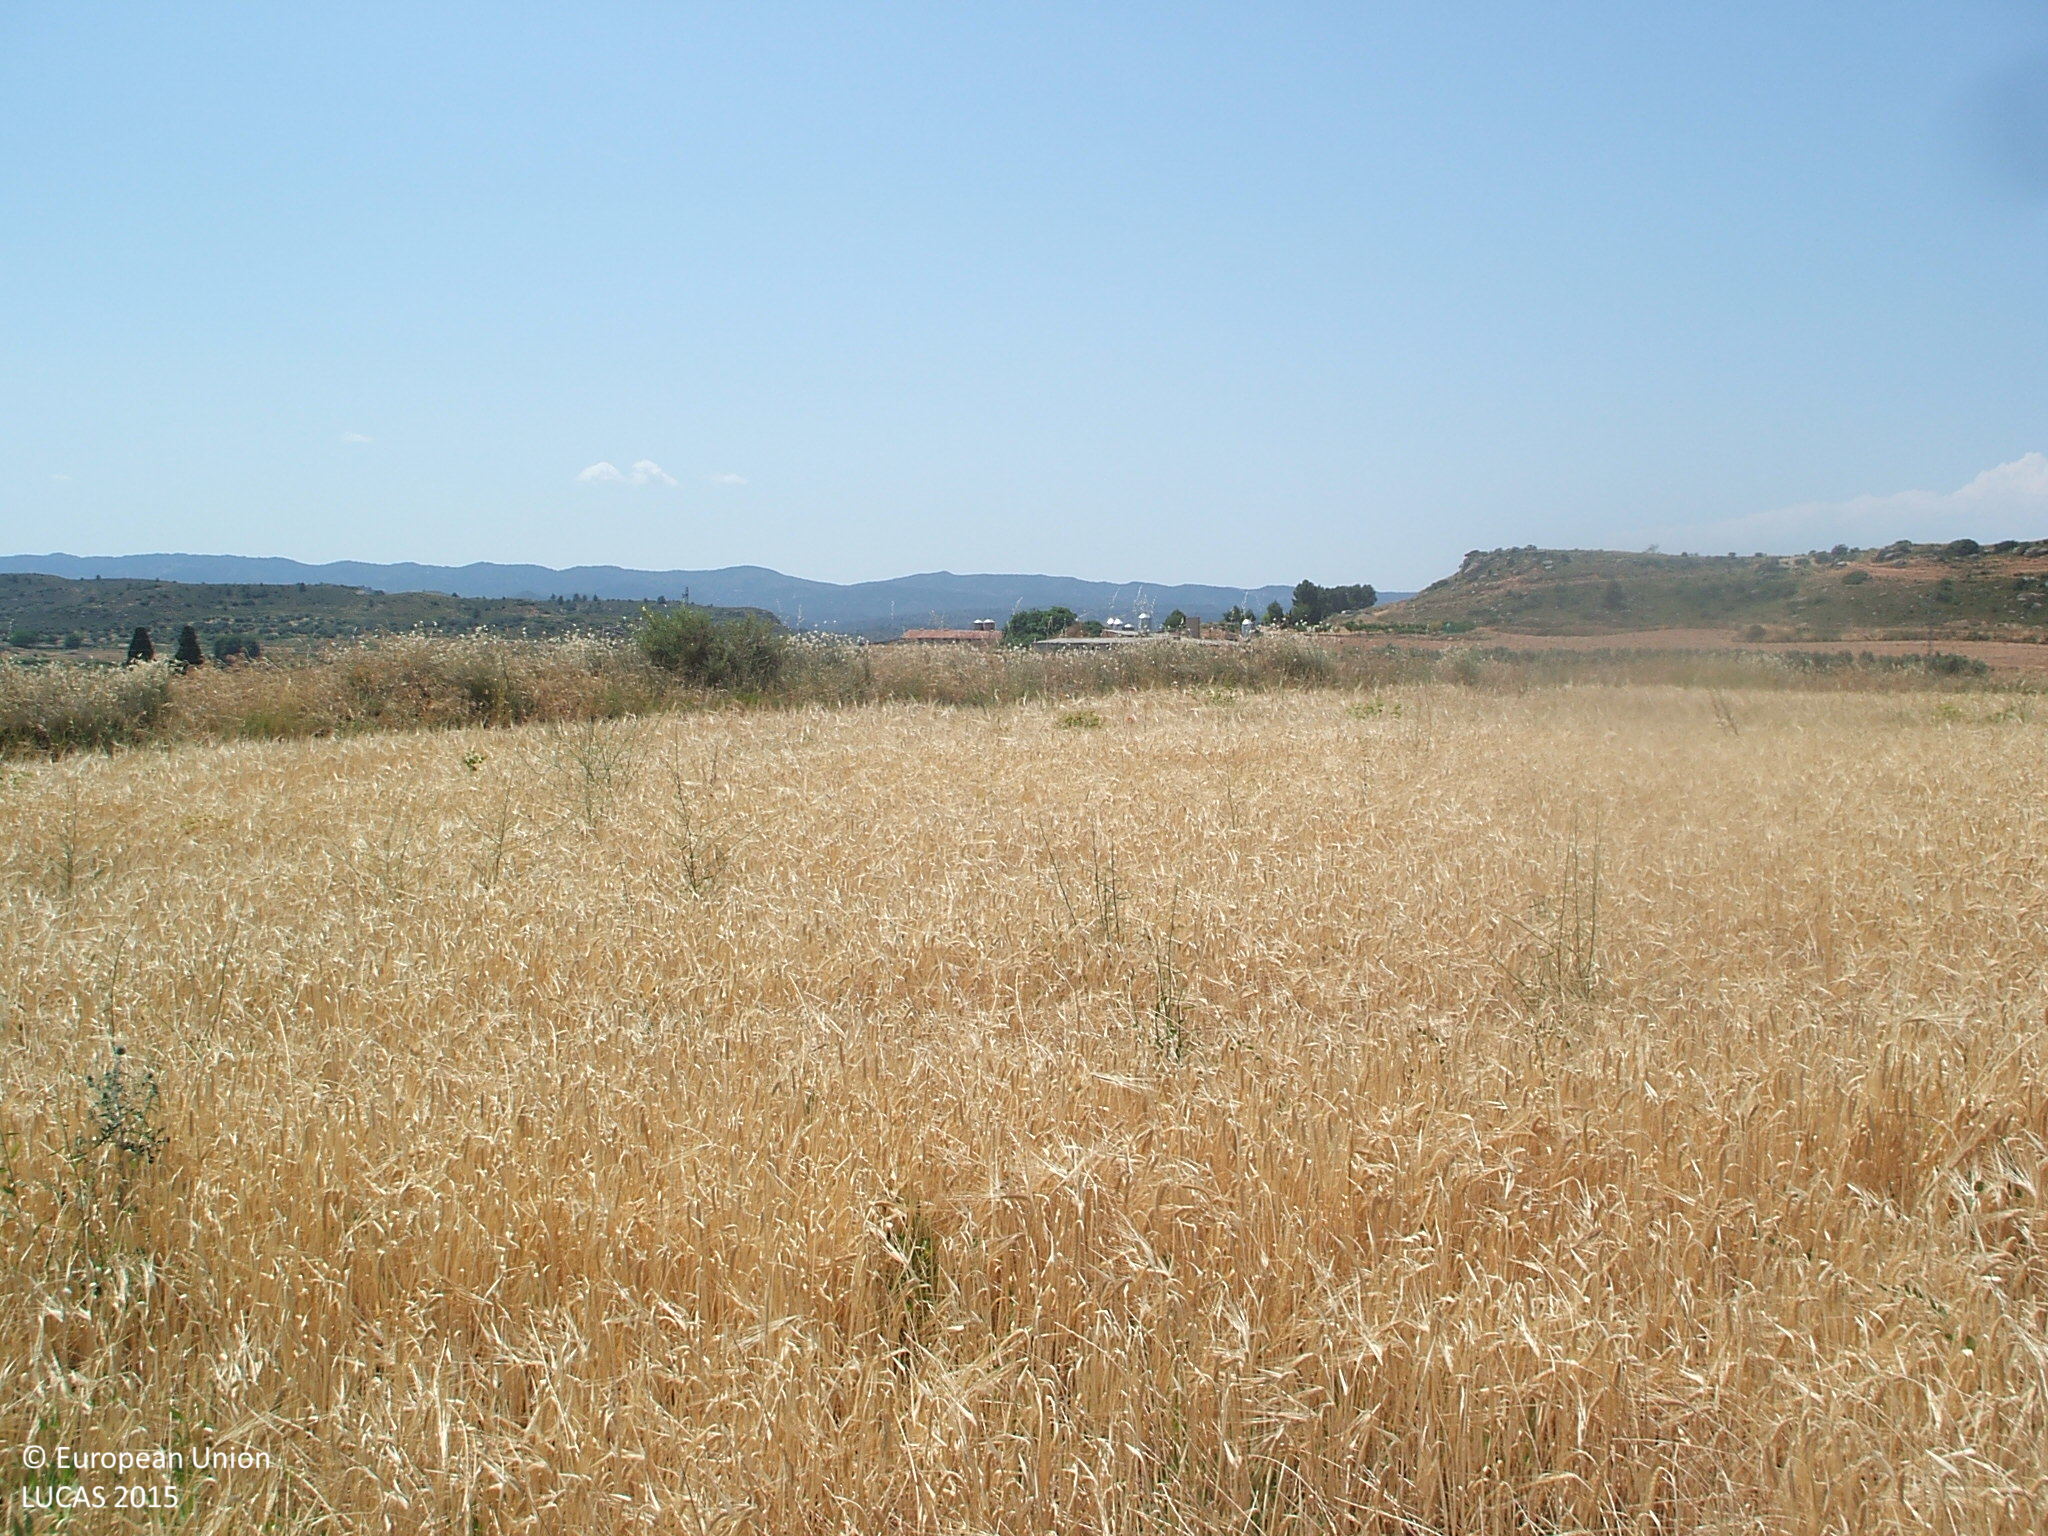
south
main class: Cropland
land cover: Barley
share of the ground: > 75 %
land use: Agriculture (excluding fallow land and kitchen gardens)
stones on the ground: > 50 %
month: June
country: ES
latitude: 40.9760
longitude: -0.1719
